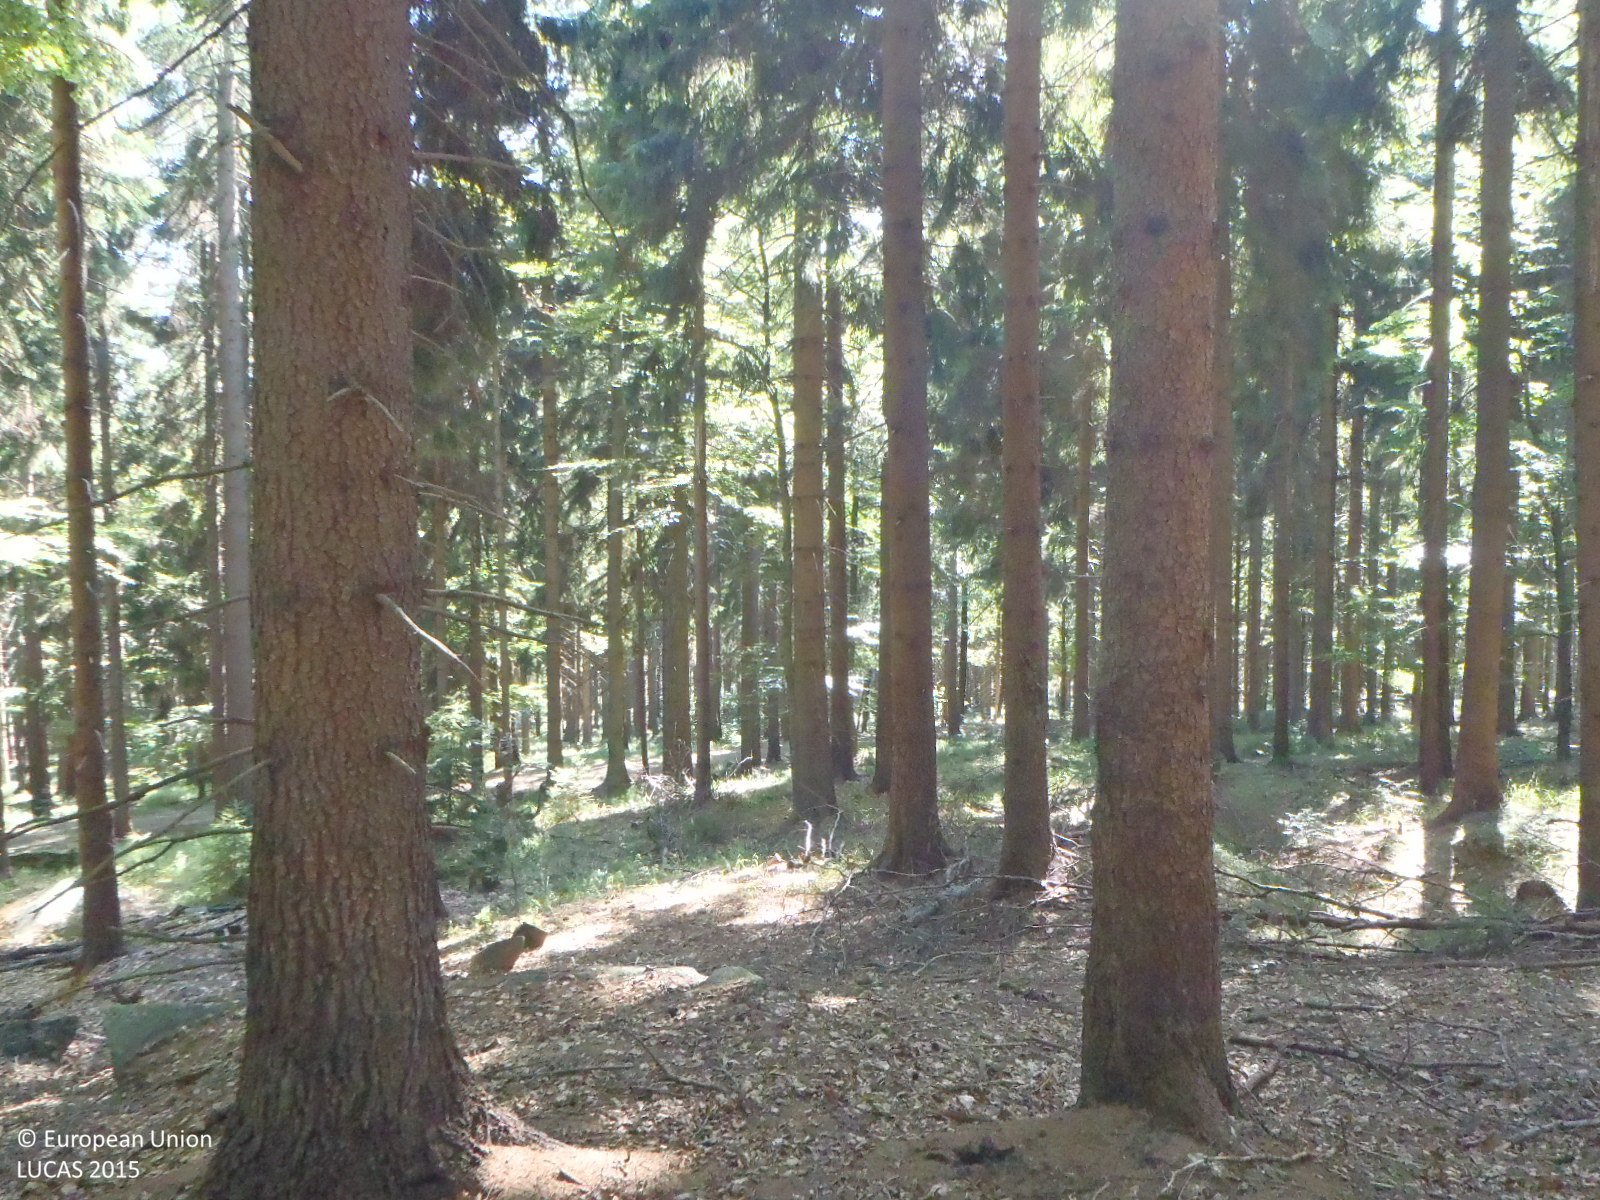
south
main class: Woodland
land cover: Other mixed woodland
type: hemiboreal forest and nemoral coniferous forest and mixed broadleaved-coniferous forest
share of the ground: > 75 %
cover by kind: broadleaved forest trees 60 %, coniferous forest trees 40 %
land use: Forestry
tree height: > 5 m
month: August
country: CZ
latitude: 50.8124
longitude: 14.5862
